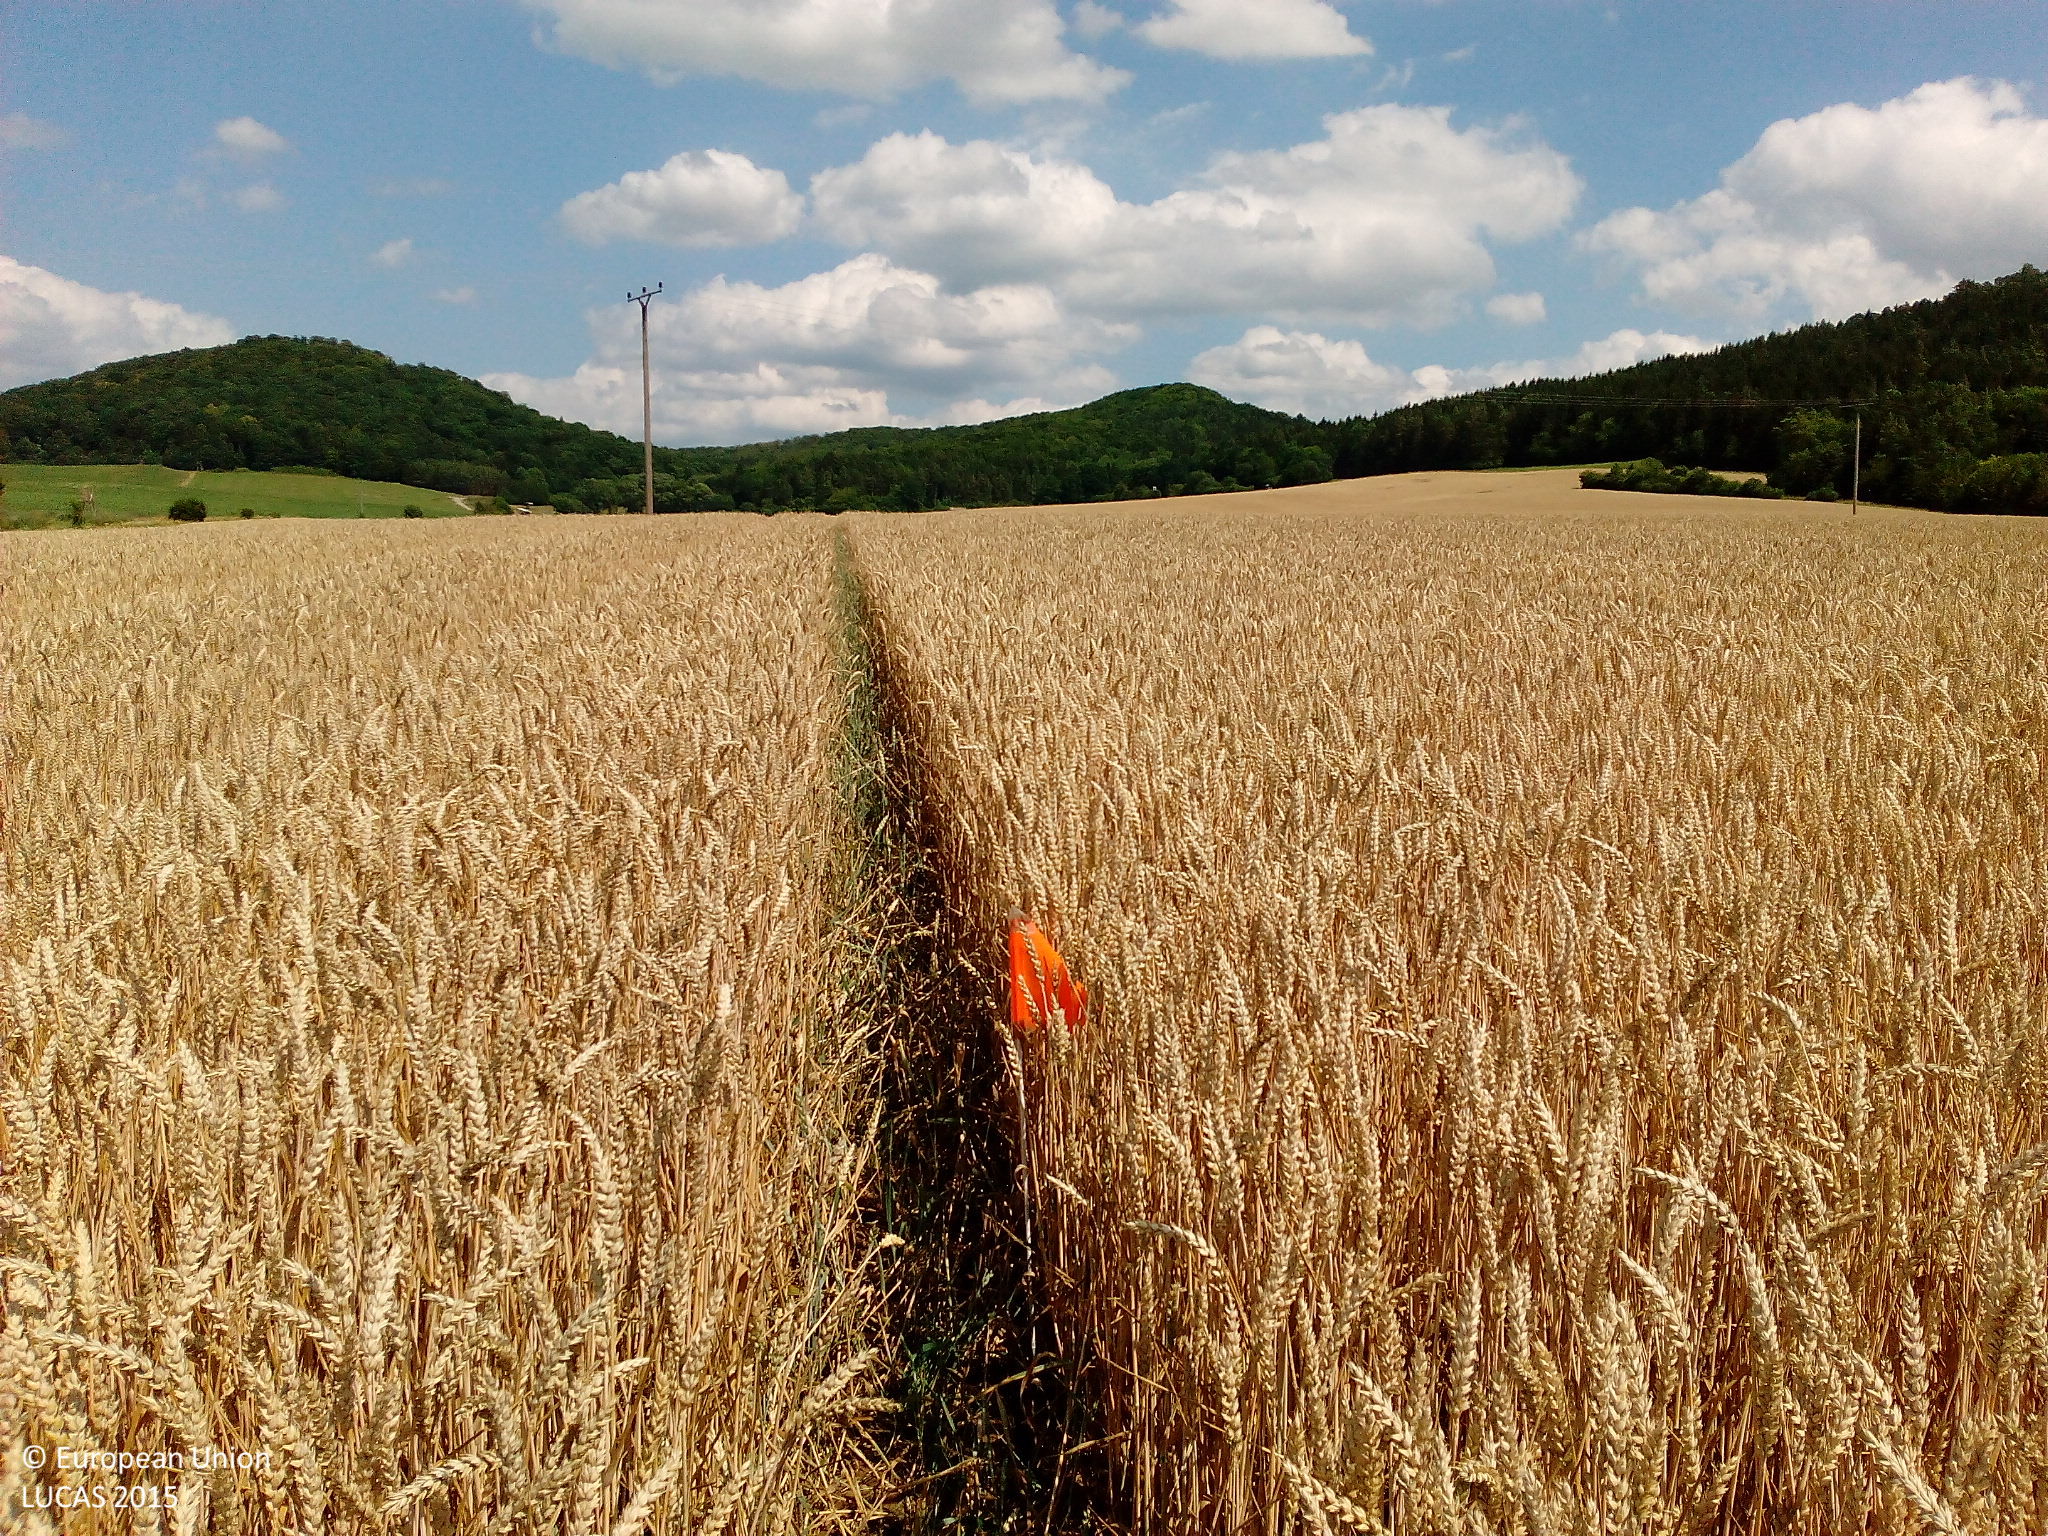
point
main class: Cropland
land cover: Common wheat
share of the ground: > 75 %
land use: Agriculture (excluding fallow land and kitchen gardens)
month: July
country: DE
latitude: 50.7596
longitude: 9.9575
